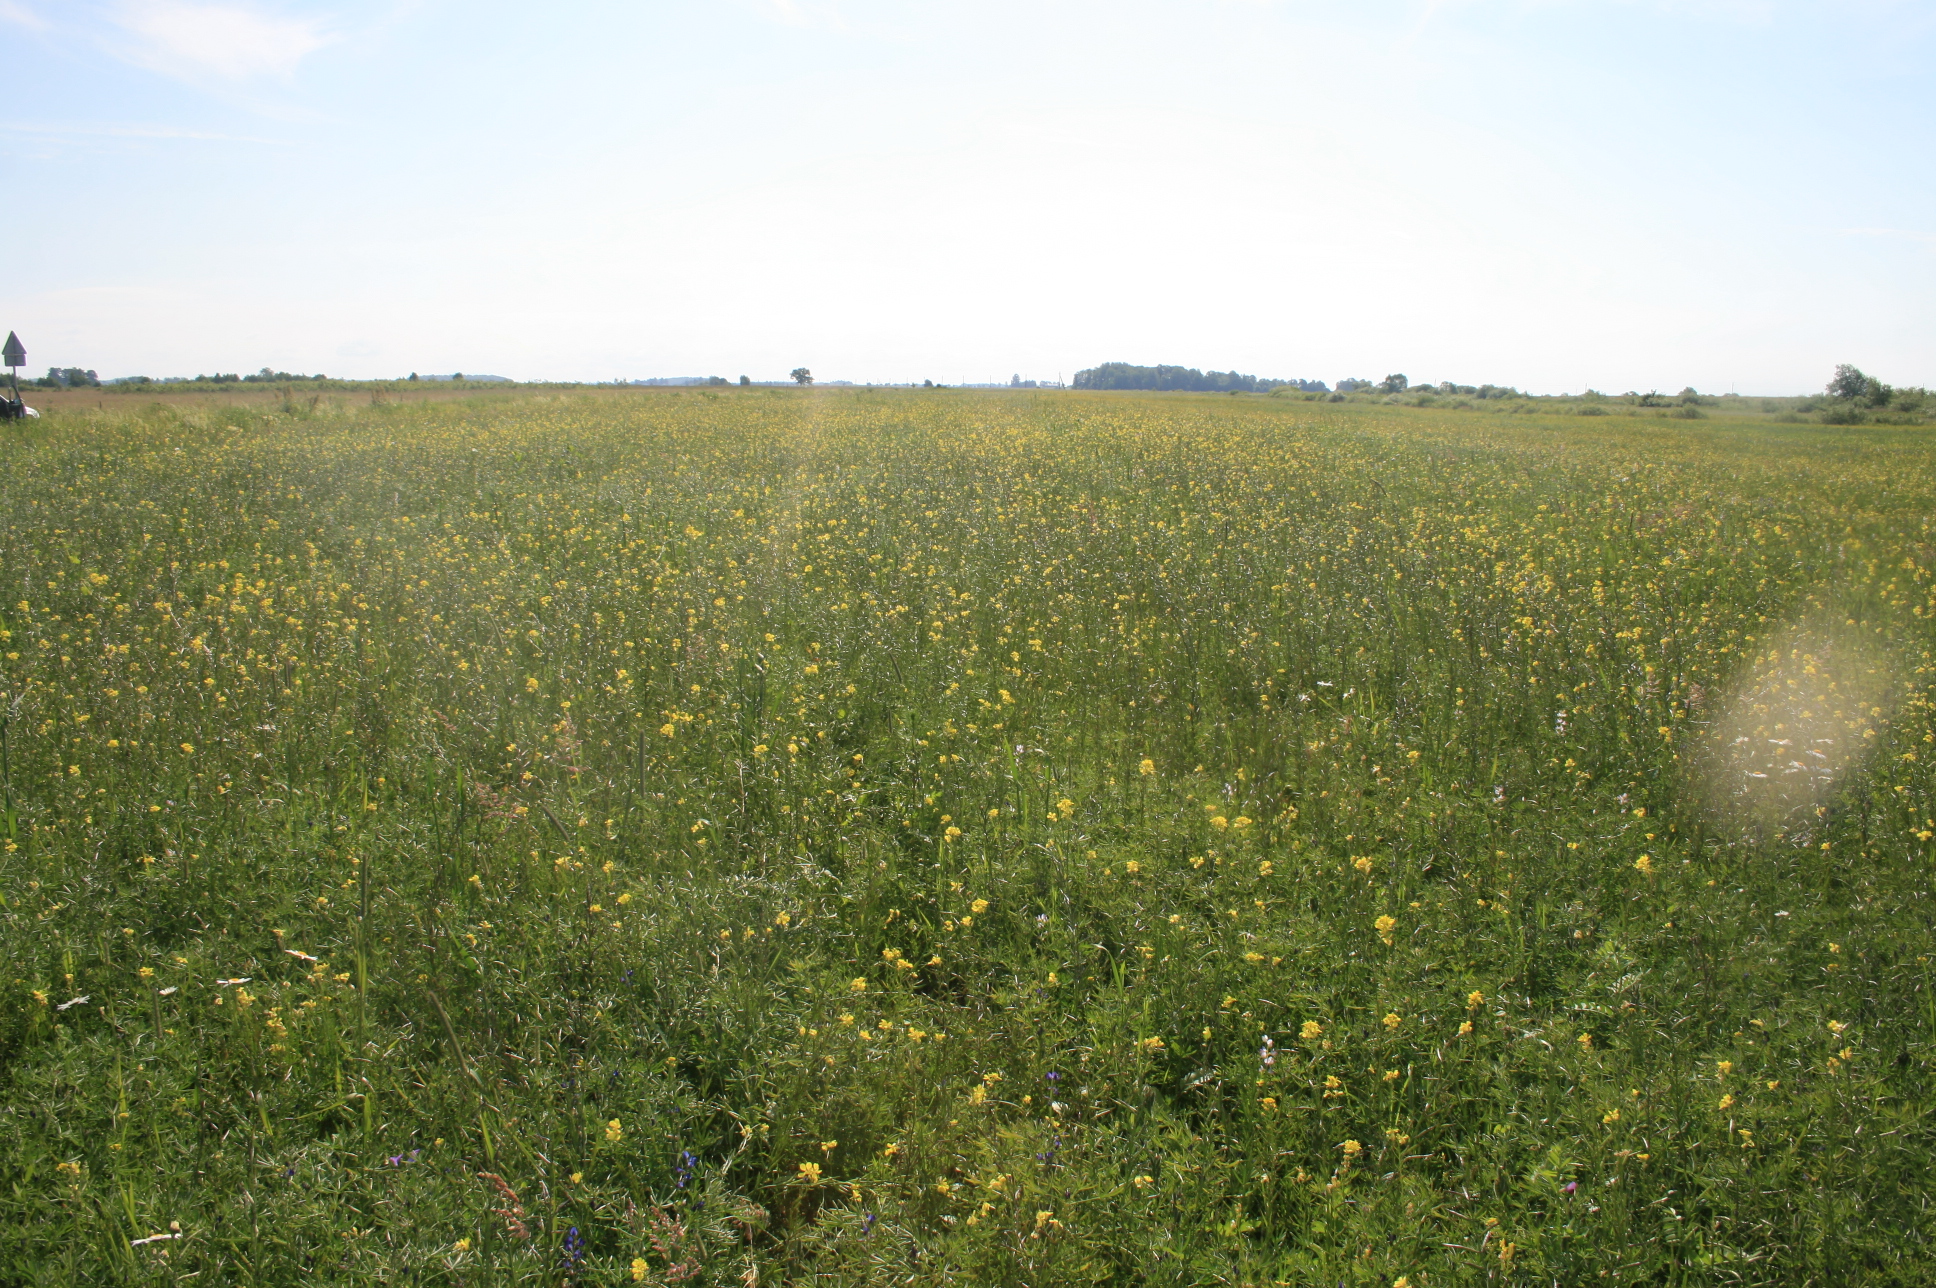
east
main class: Cropland
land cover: Dry pulses
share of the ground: > 75 %
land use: Agriculture (excluding fallow land and kitchen gardens)
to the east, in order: Dry pulses; Grass margins; Ditches and canals; Grass margins; Paved roads, cycling and walking lanes; Grass margins; Ditches and canals; Grass margins; Fences; Grassland without tree/shrub cover
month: June
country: LT
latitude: 55.2851
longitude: 21.7166
